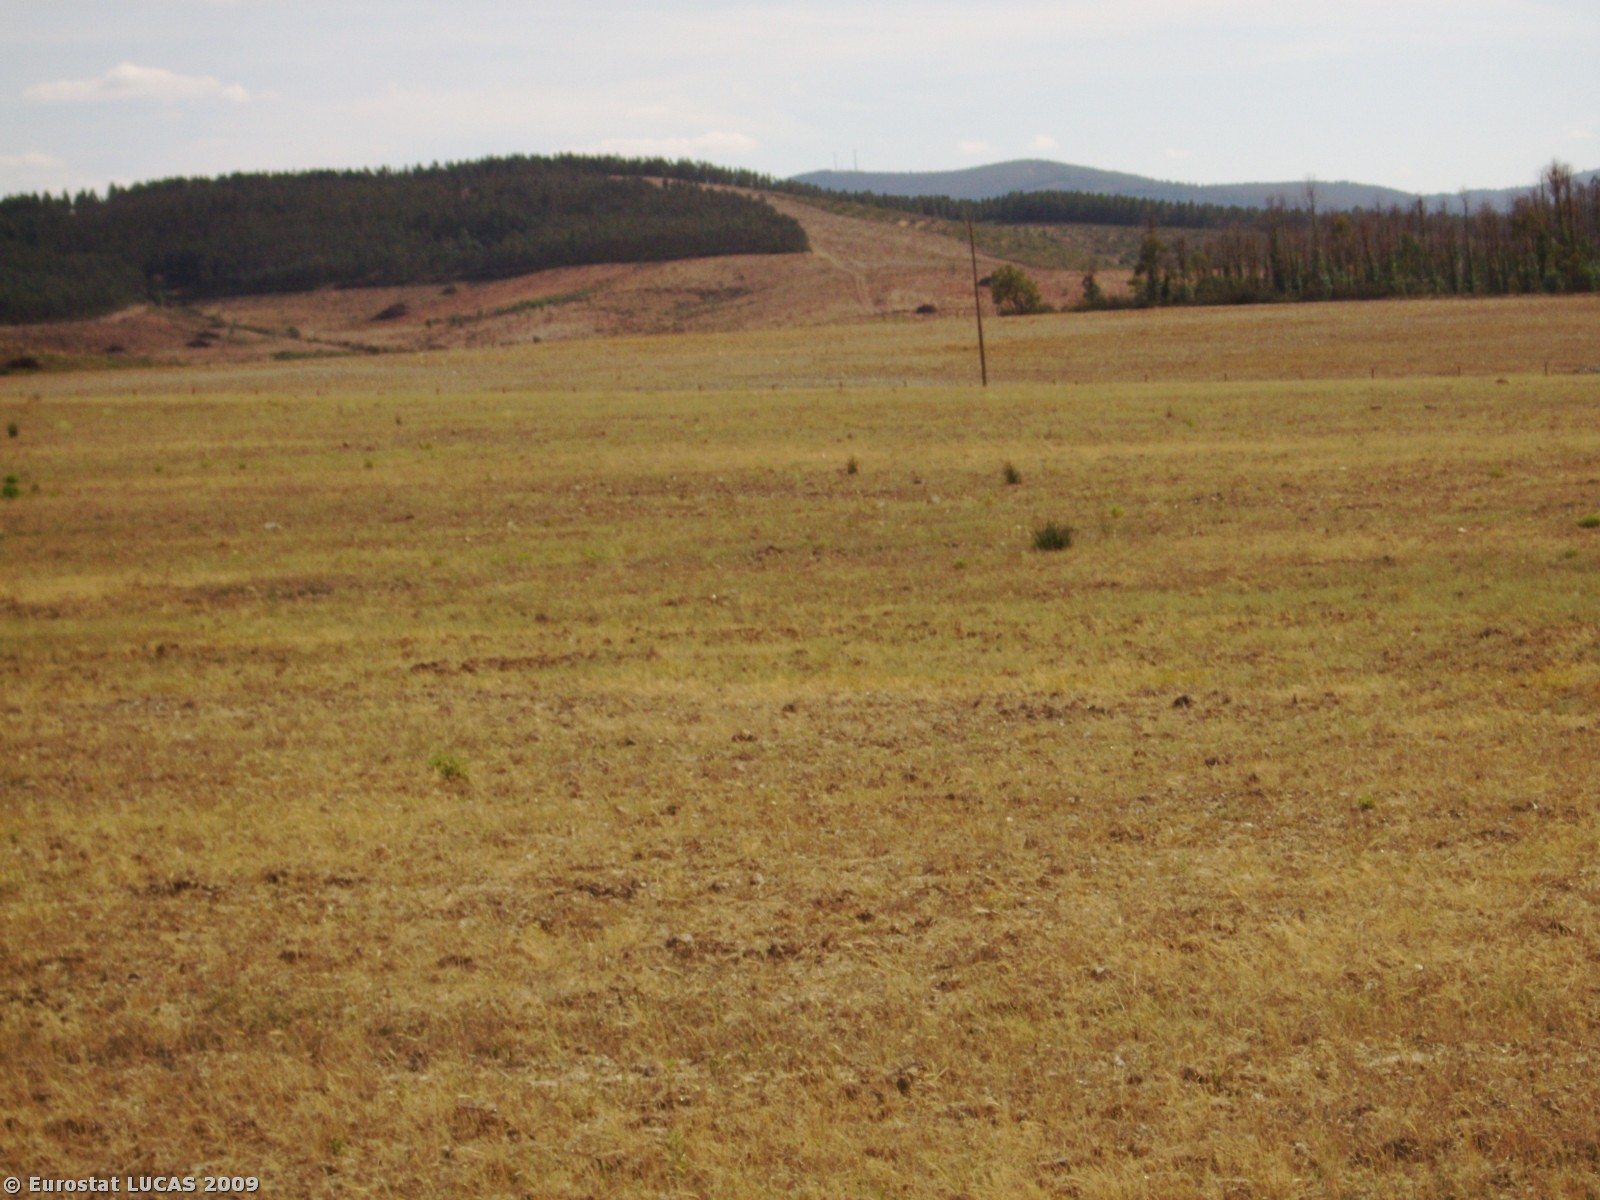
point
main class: Grassland
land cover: Spontaneously vegetated surfaces
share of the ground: > 75 %
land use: Fallow land
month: June
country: PT
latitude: 40.1834
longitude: -7.3550
